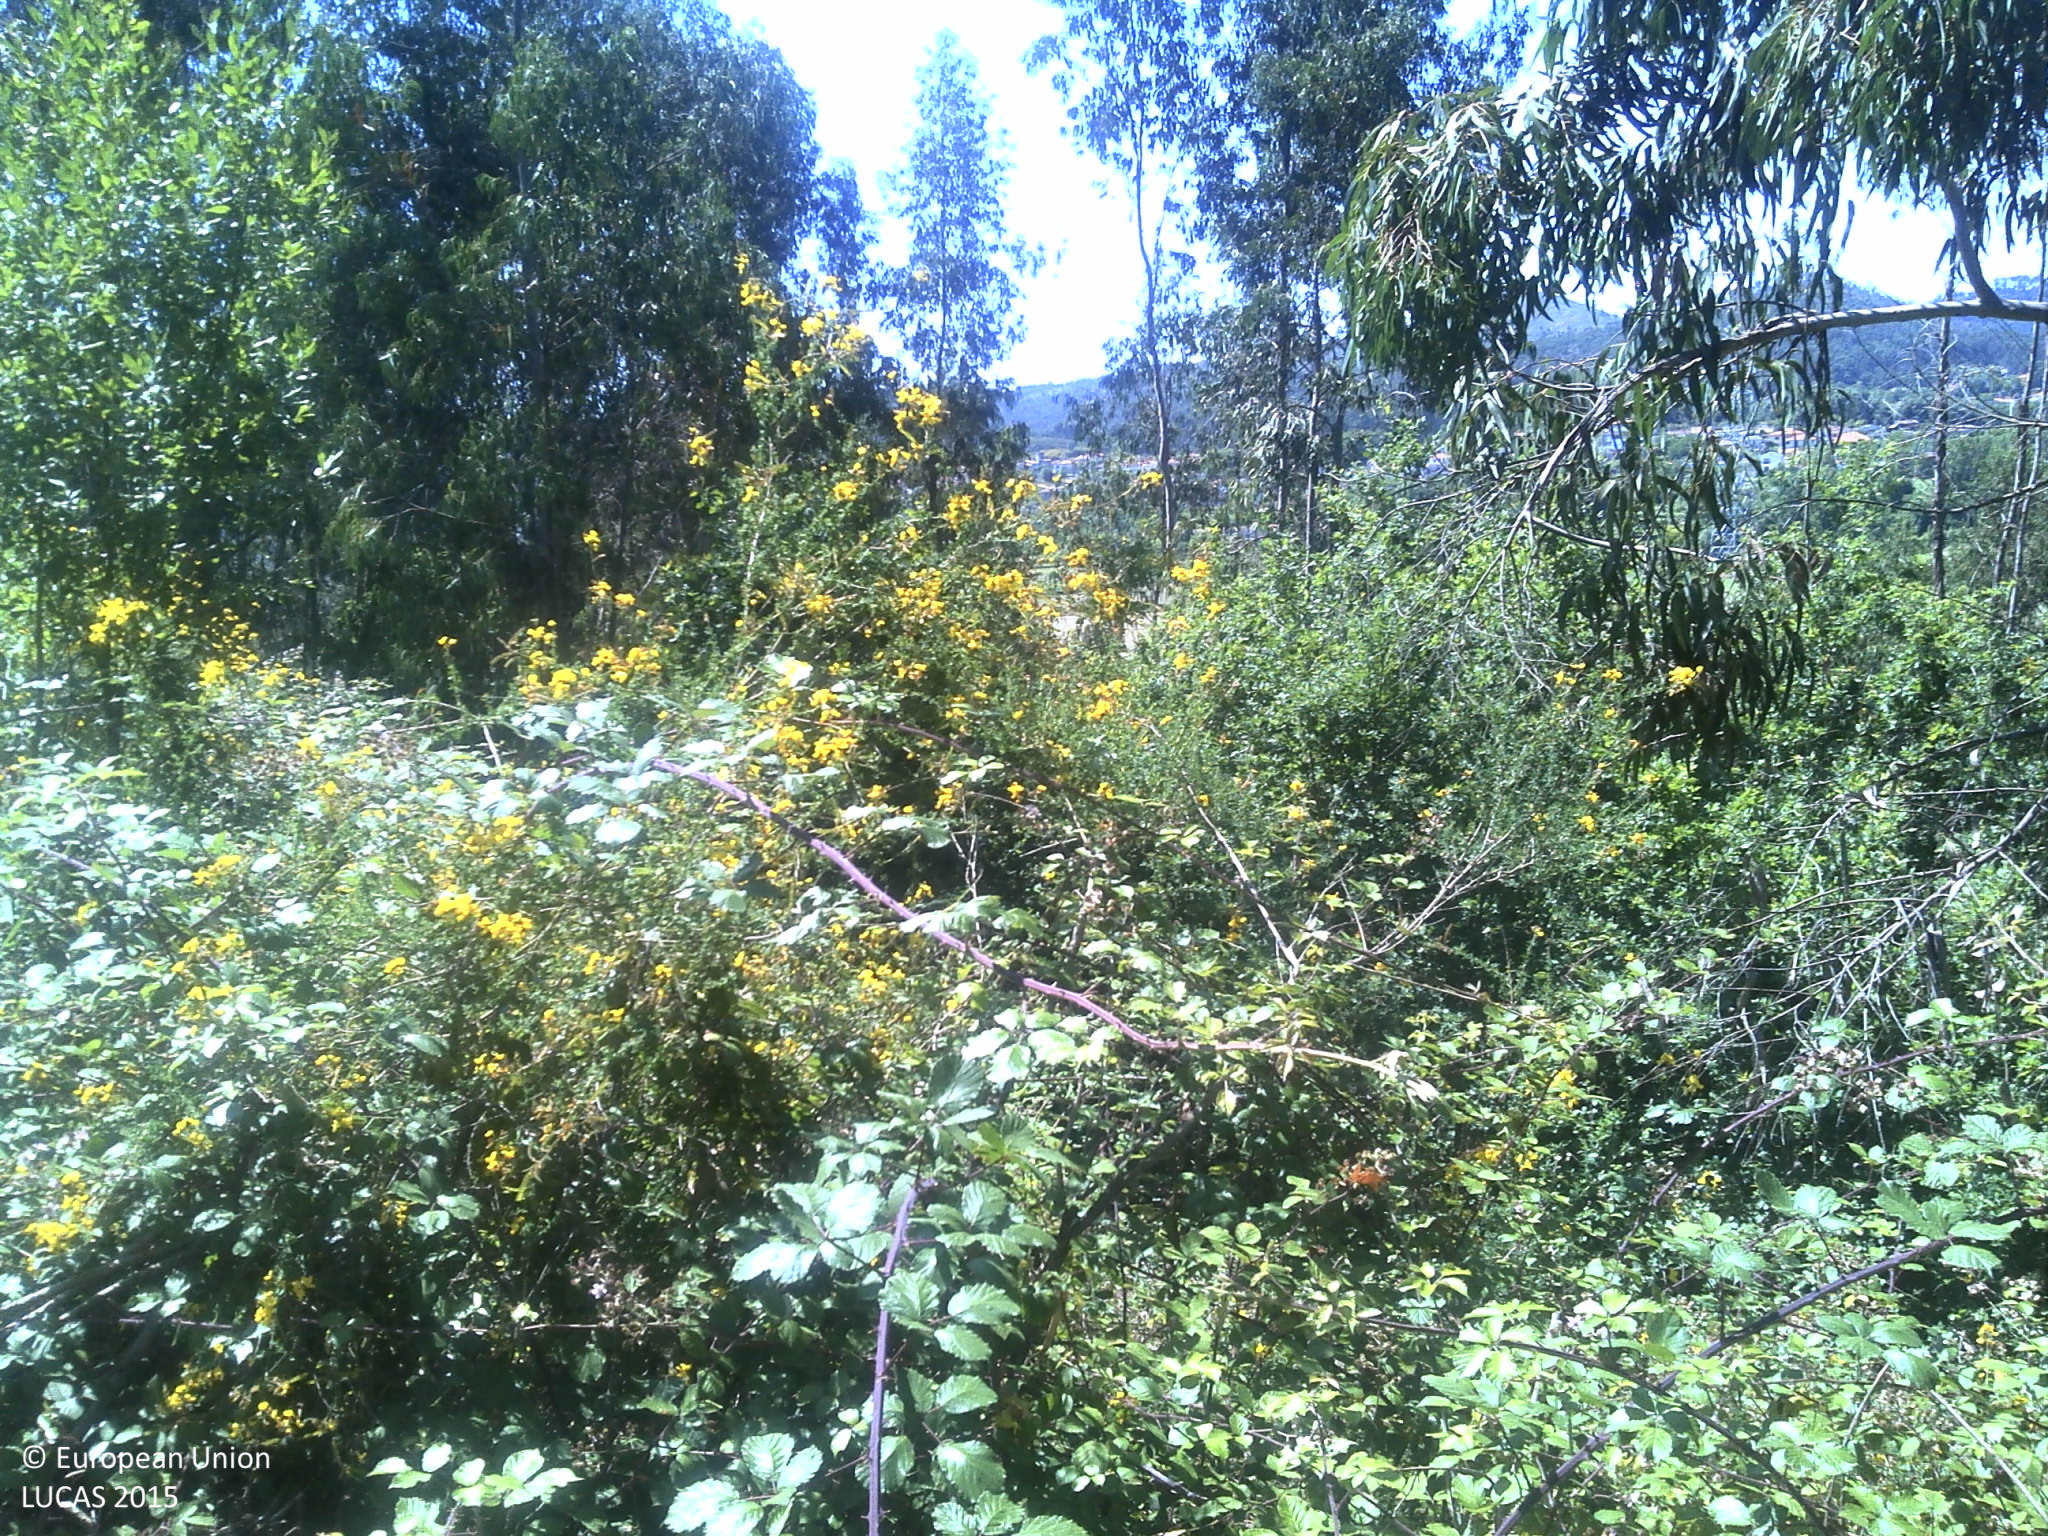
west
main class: Shrubland
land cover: Shrubland with sparse tree cover
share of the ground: > 75 %
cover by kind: shrubs 85 %, unconsolidated bare surface 10 %, broadleaved forest trees 5 %
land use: Semi-natural and natural areas not in use
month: June
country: PT
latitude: 41.5274
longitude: -8.2819
